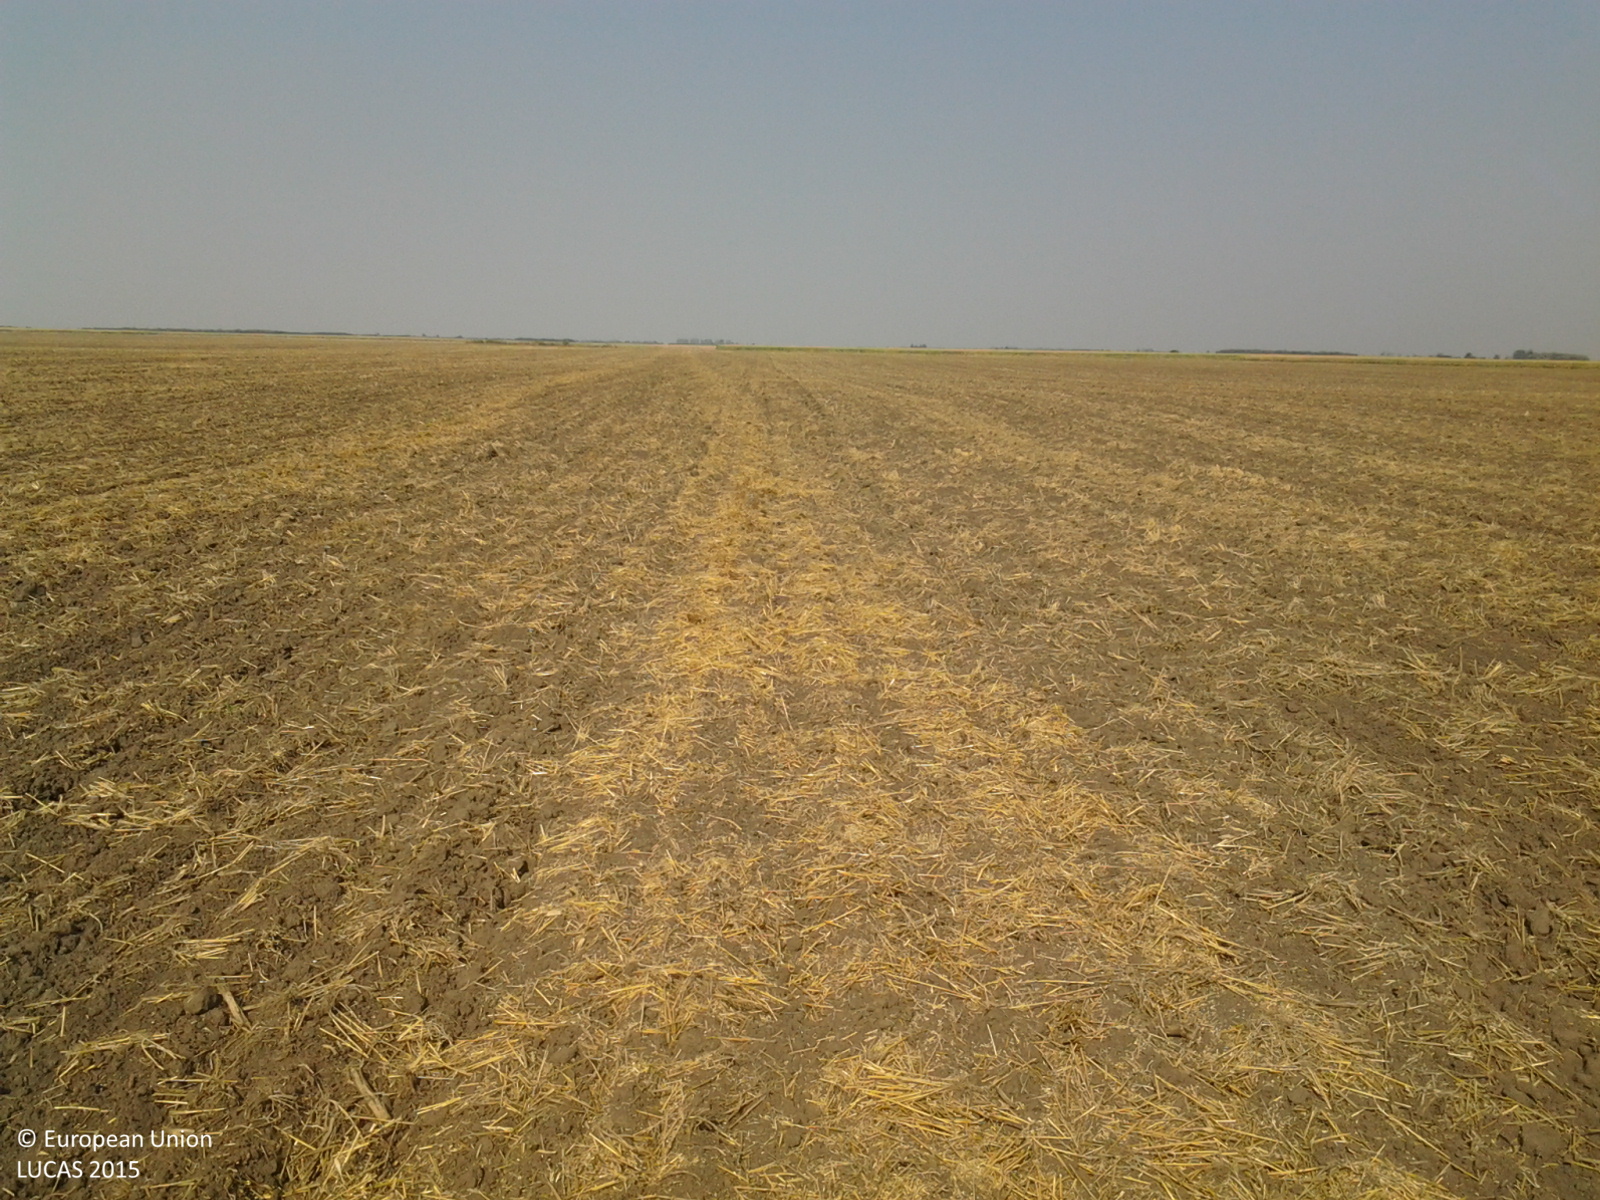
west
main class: Cropland
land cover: Common wheat
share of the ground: 10 - 25 %
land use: Agriculture (excluding fallow land and kitchen gardens)
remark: Harvested field
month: August
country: HU
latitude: 46.3131
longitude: 21.1354
